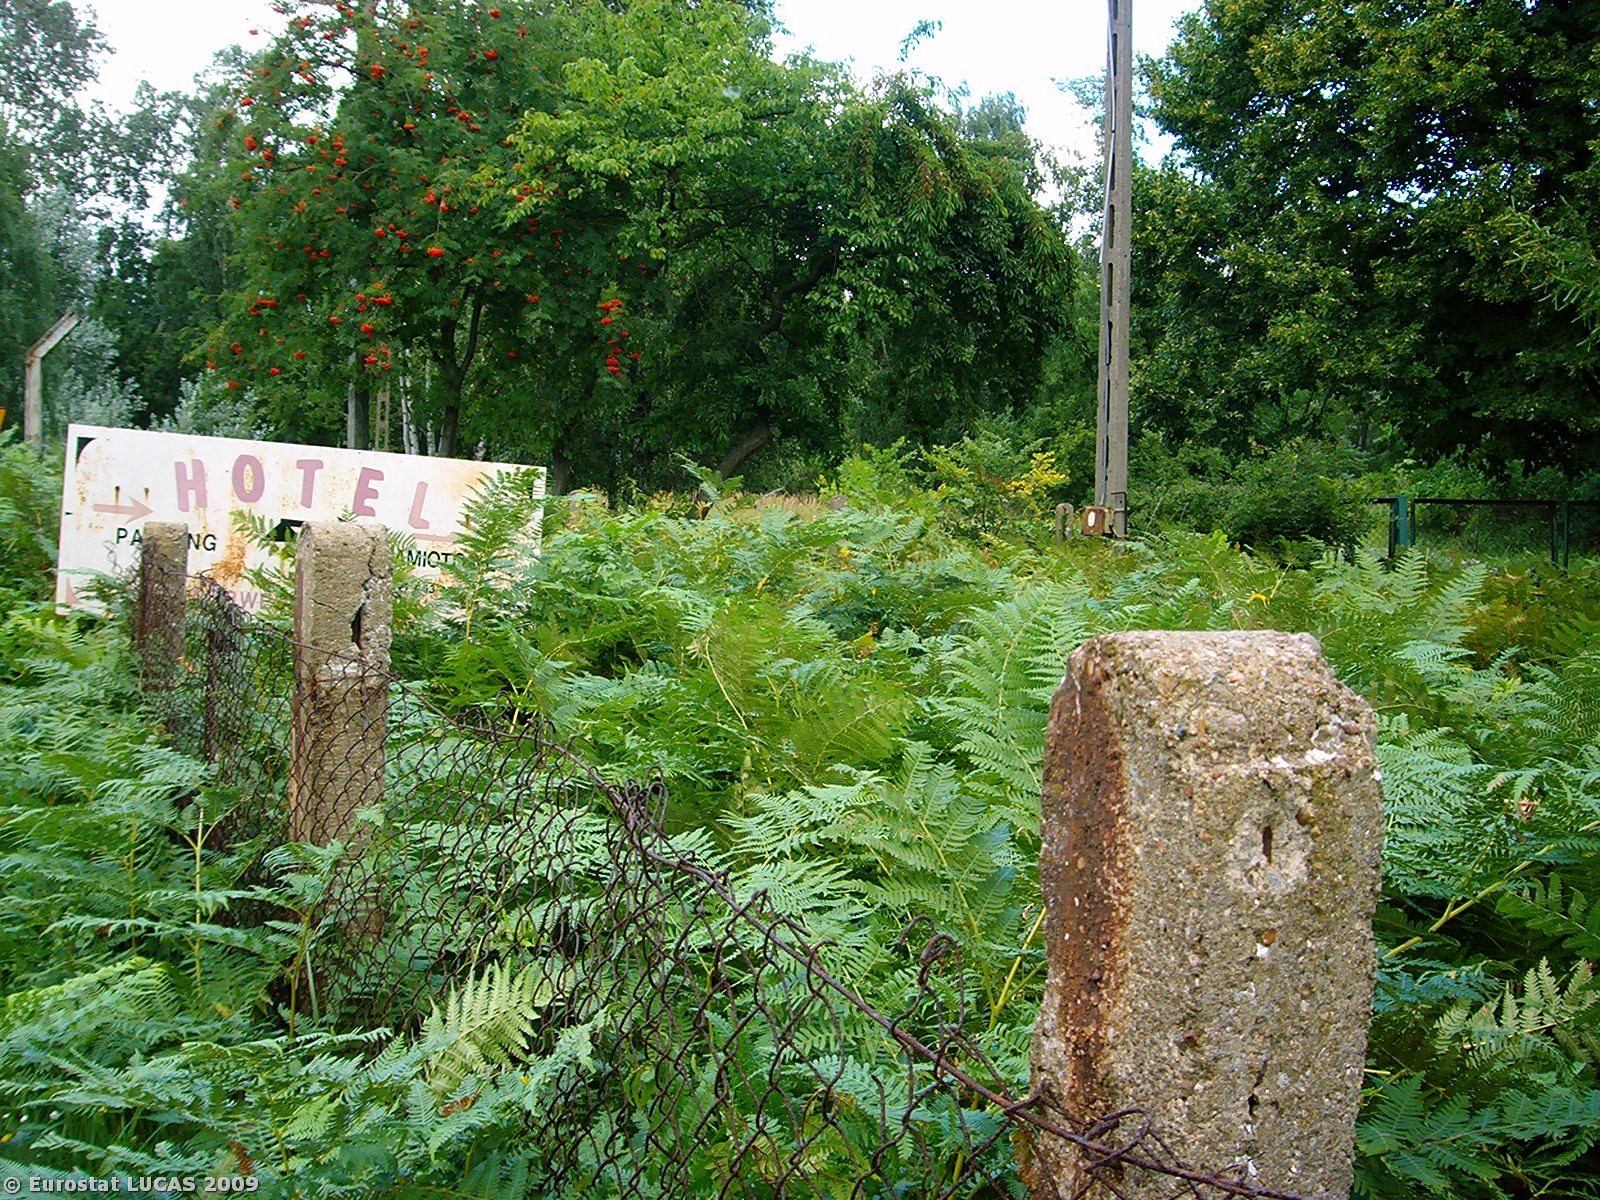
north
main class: Grassland
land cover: Grassland with sparse tree/shrub cover
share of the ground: > 75 %
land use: Residential
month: August
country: PL
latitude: 53.9024
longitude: 14.2773
